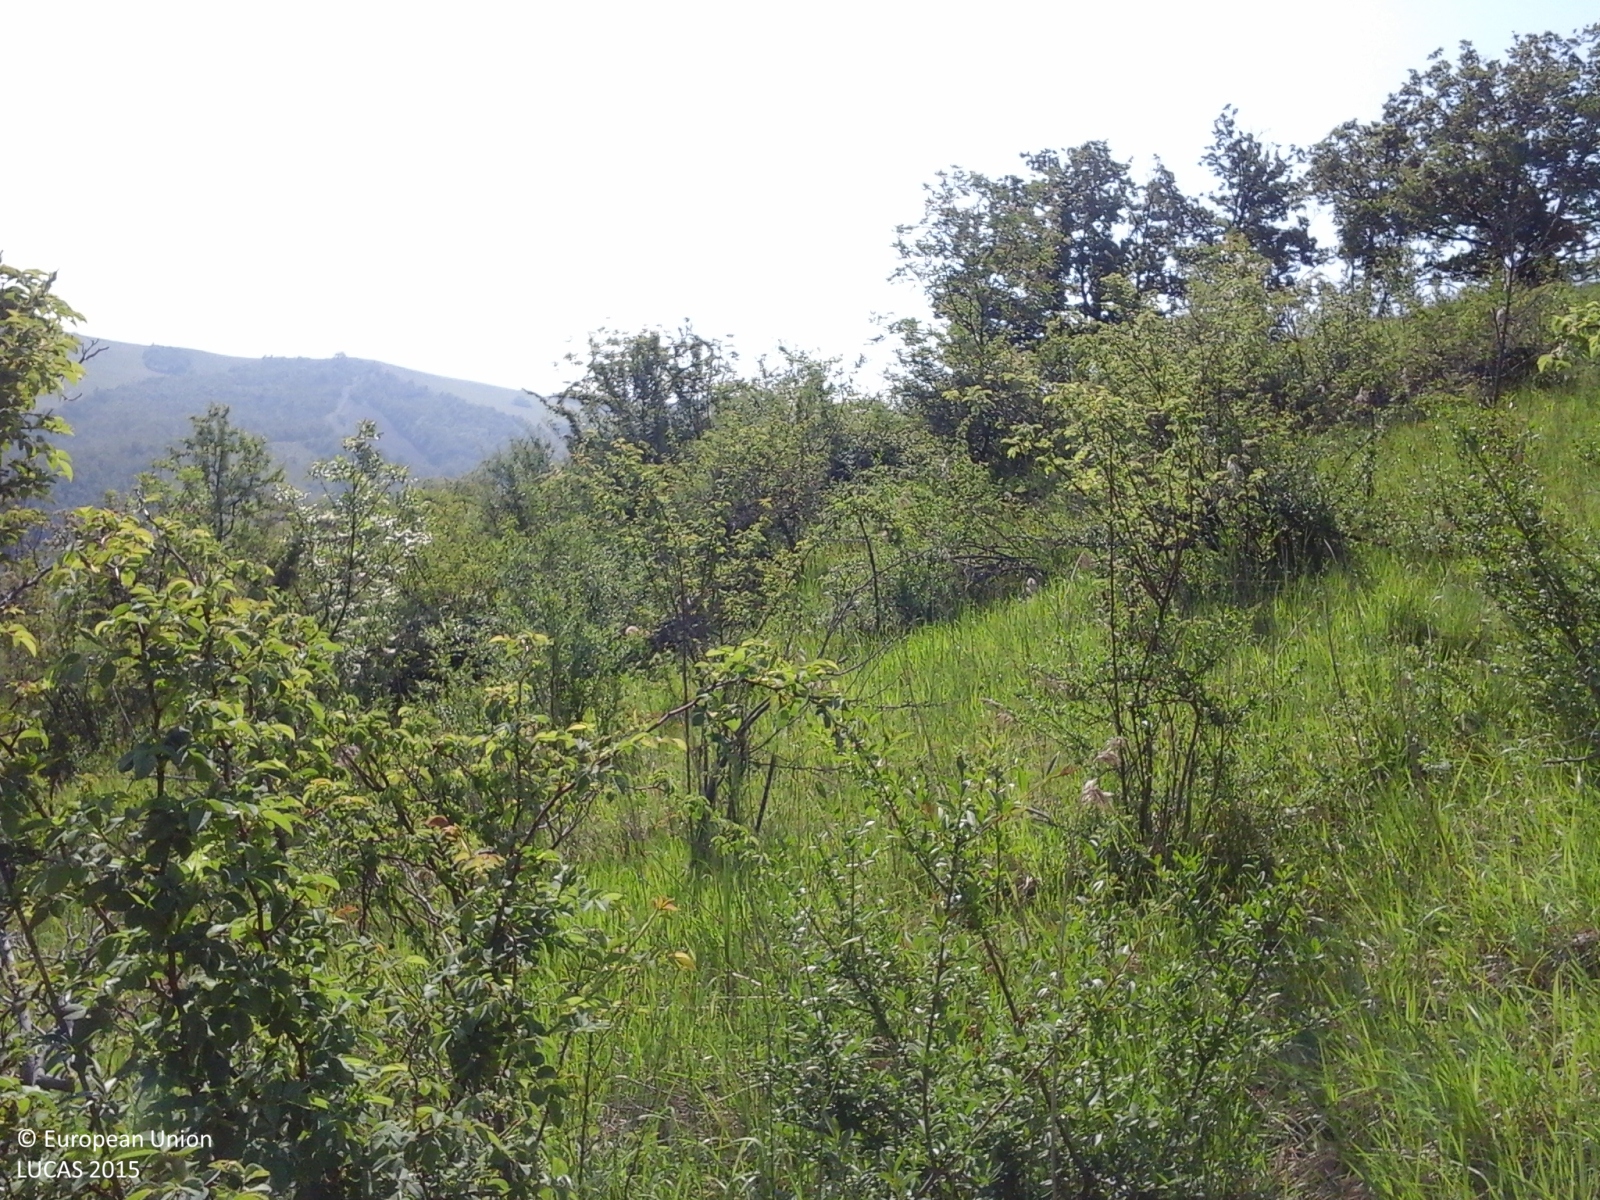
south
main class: Shrubland
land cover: Shrubland with sparse tree cover
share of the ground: 50 - 75 %
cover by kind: shrubs 60 %, herbaceous plants 35 %, broadleaved forest trees 5 %
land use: Semi-natural and natural areas not in use
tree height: > 5 m
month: May
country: IT
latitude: 44.4734
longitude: 10.8404
